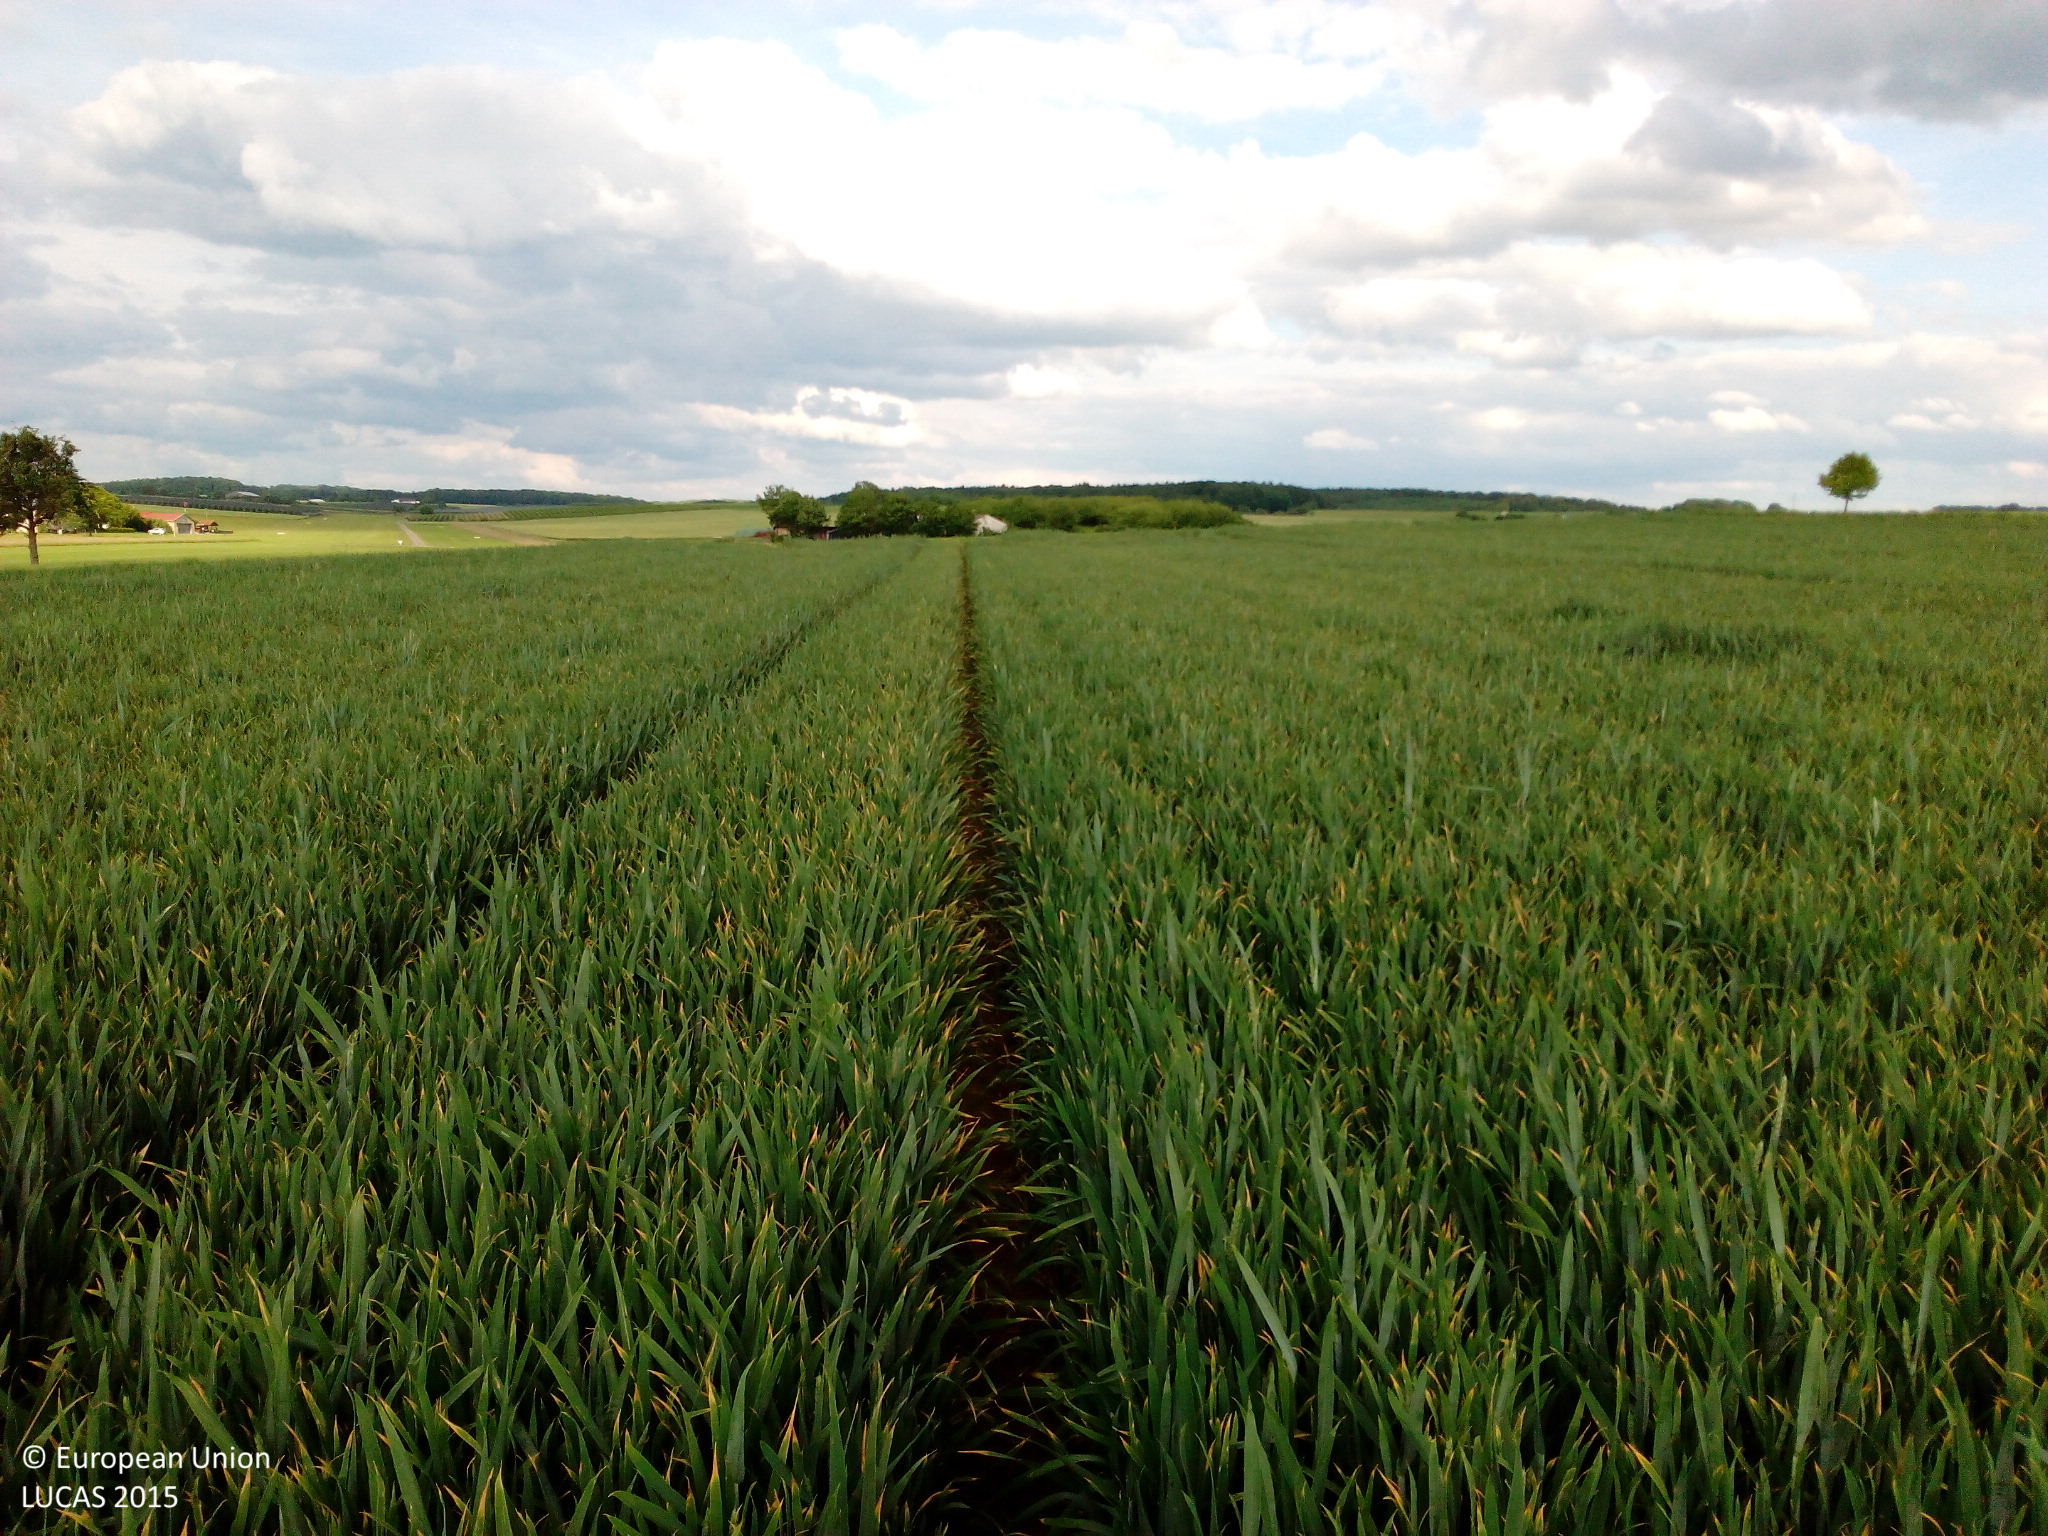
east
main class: Cropland
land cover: Common wheat
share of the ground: > 75 %
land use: Agriculture (excluding fallow land and kitchen gardens)
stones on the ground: < 10 %
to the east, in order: Common wheat; Tracks; Sugar beet; Tracks; Sugar beet
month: May
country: DE
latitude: 49.2295
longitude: 9.4098
